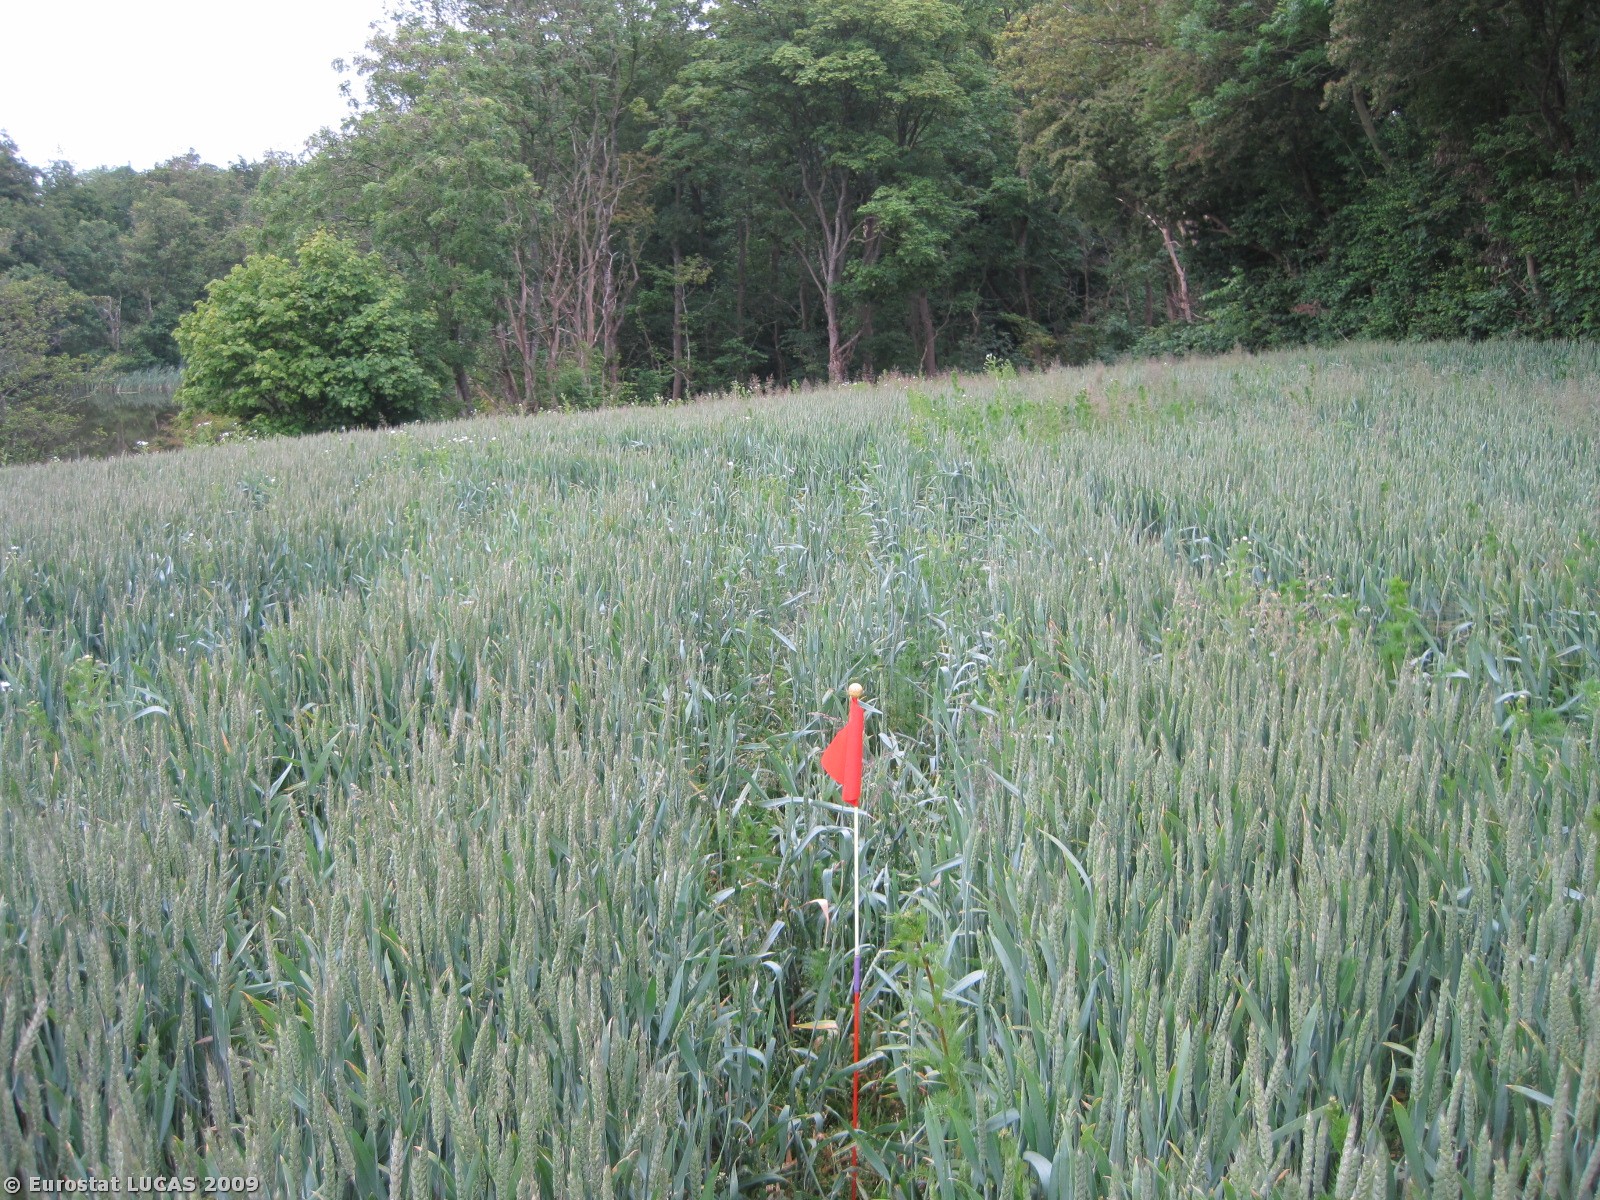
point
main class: Cropland
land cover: Common wheat
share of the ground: > 75 %
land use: Agriculture (excluding fallow land and kitchen gardens)
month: June
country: DK
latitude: 56.7392
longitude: 8.7755
